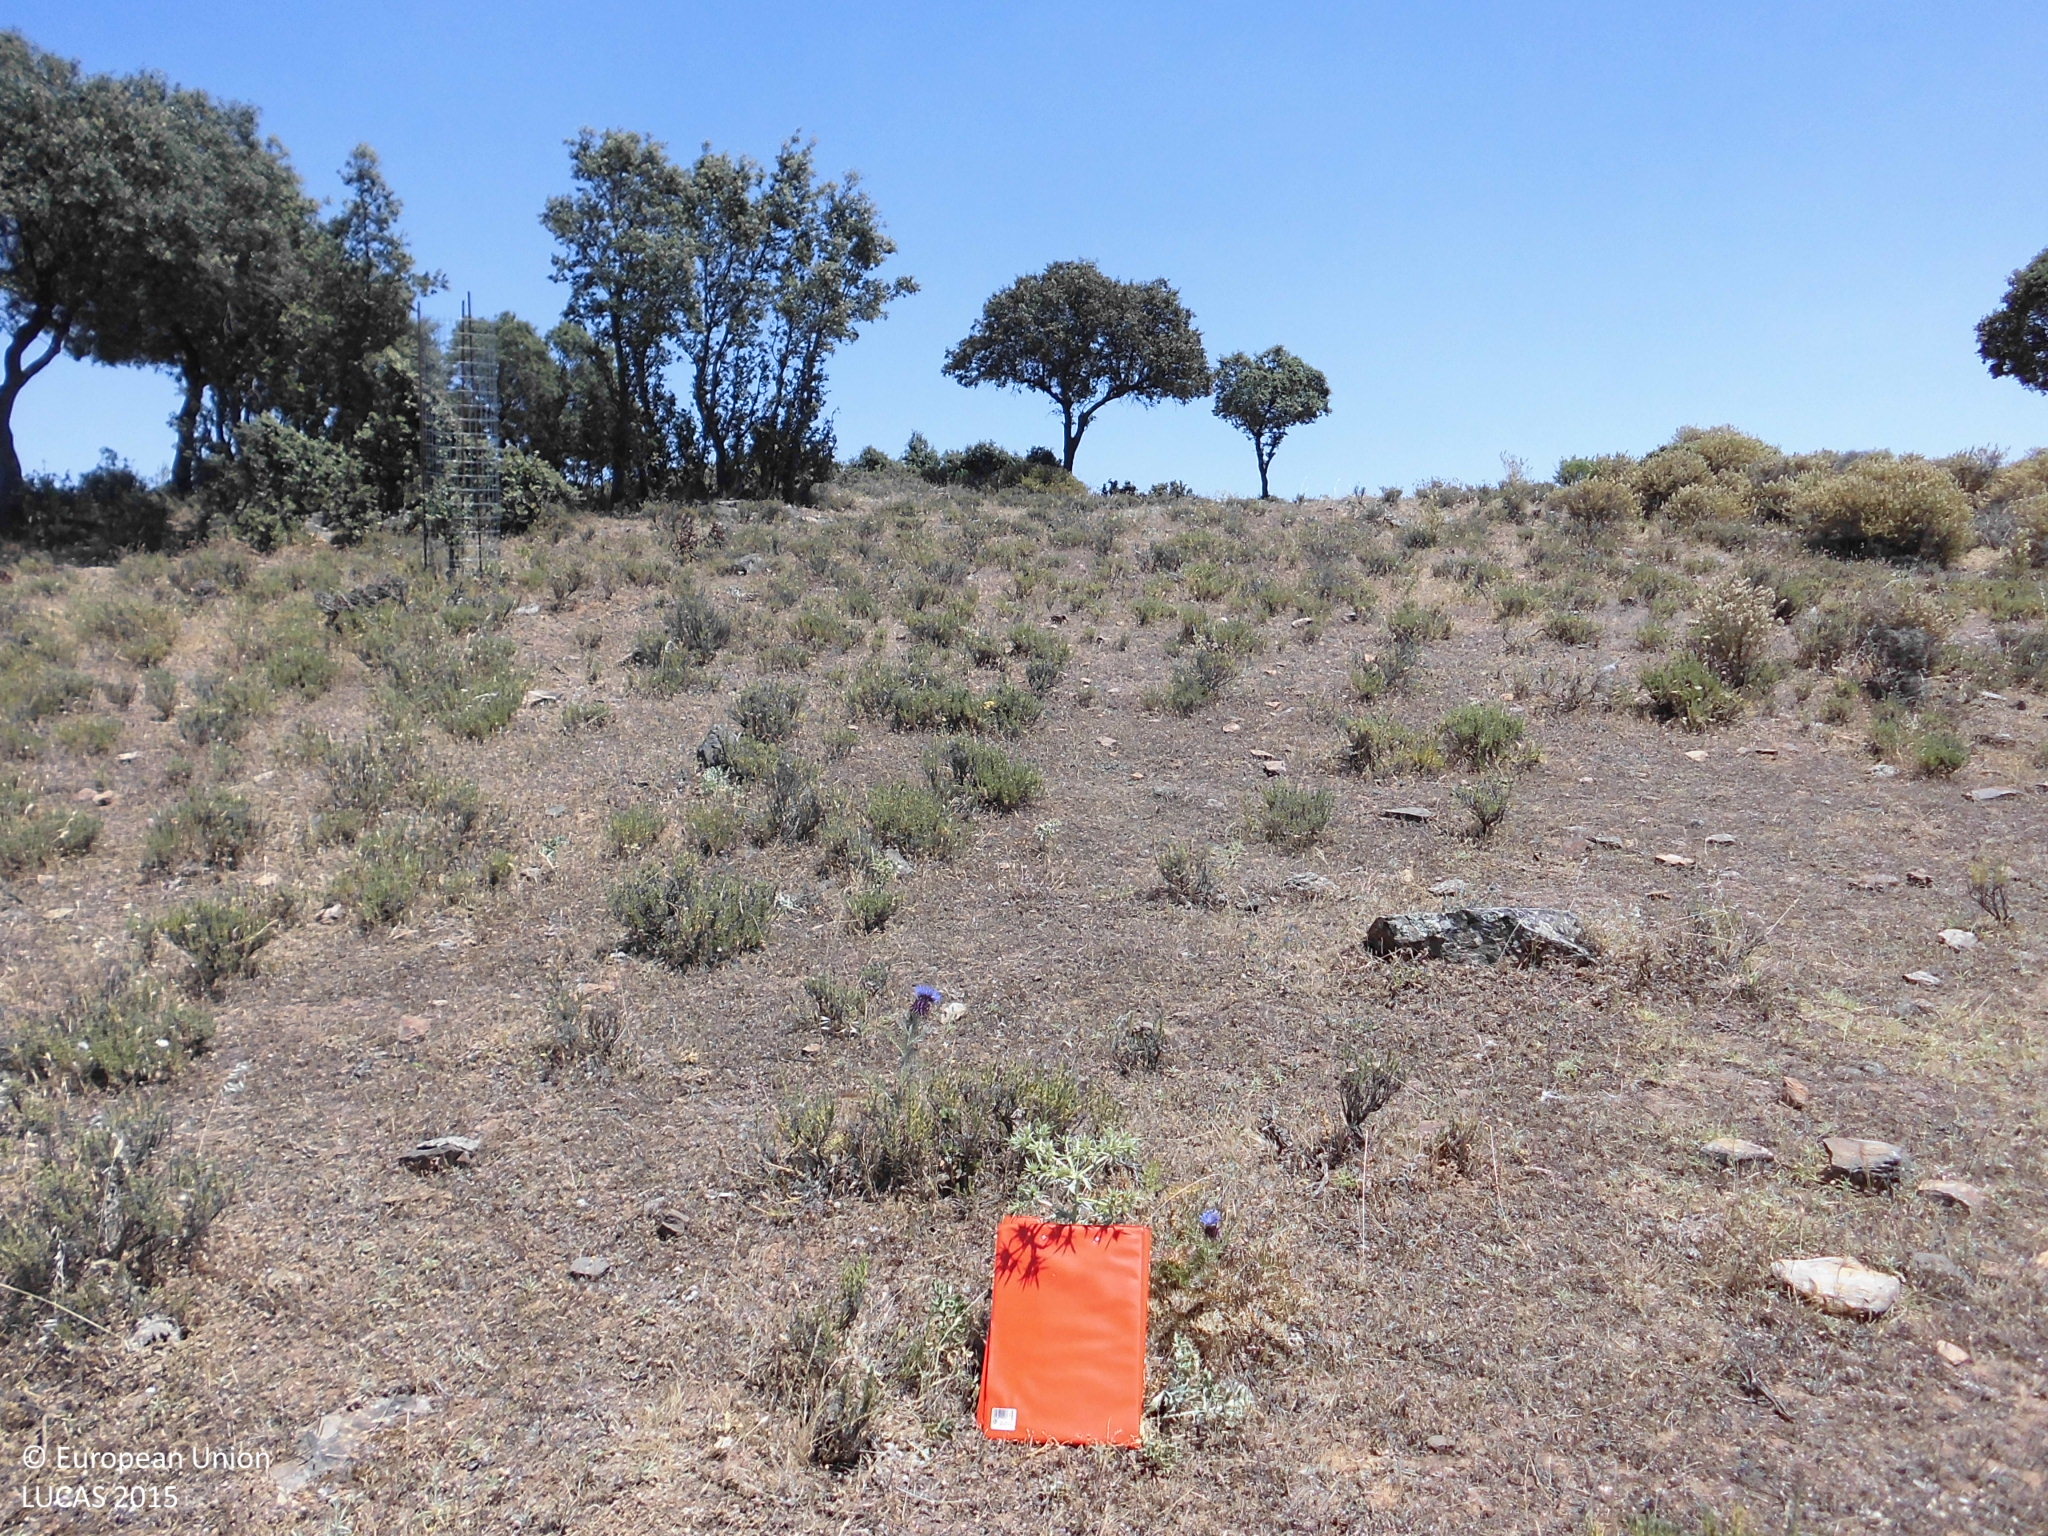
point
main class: Shrubland
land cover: Shrubland with sparse tree cover
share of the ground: 10 - 25 %
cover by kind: herbaceous plants 75 %, shrubs 20 %, broadleaved forest trees 5 %
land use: Agriculture (excluding fallow land and kitchen gardens)
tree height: > 5 m
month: May
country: ES
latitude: 39.8461
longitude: -6.7599
